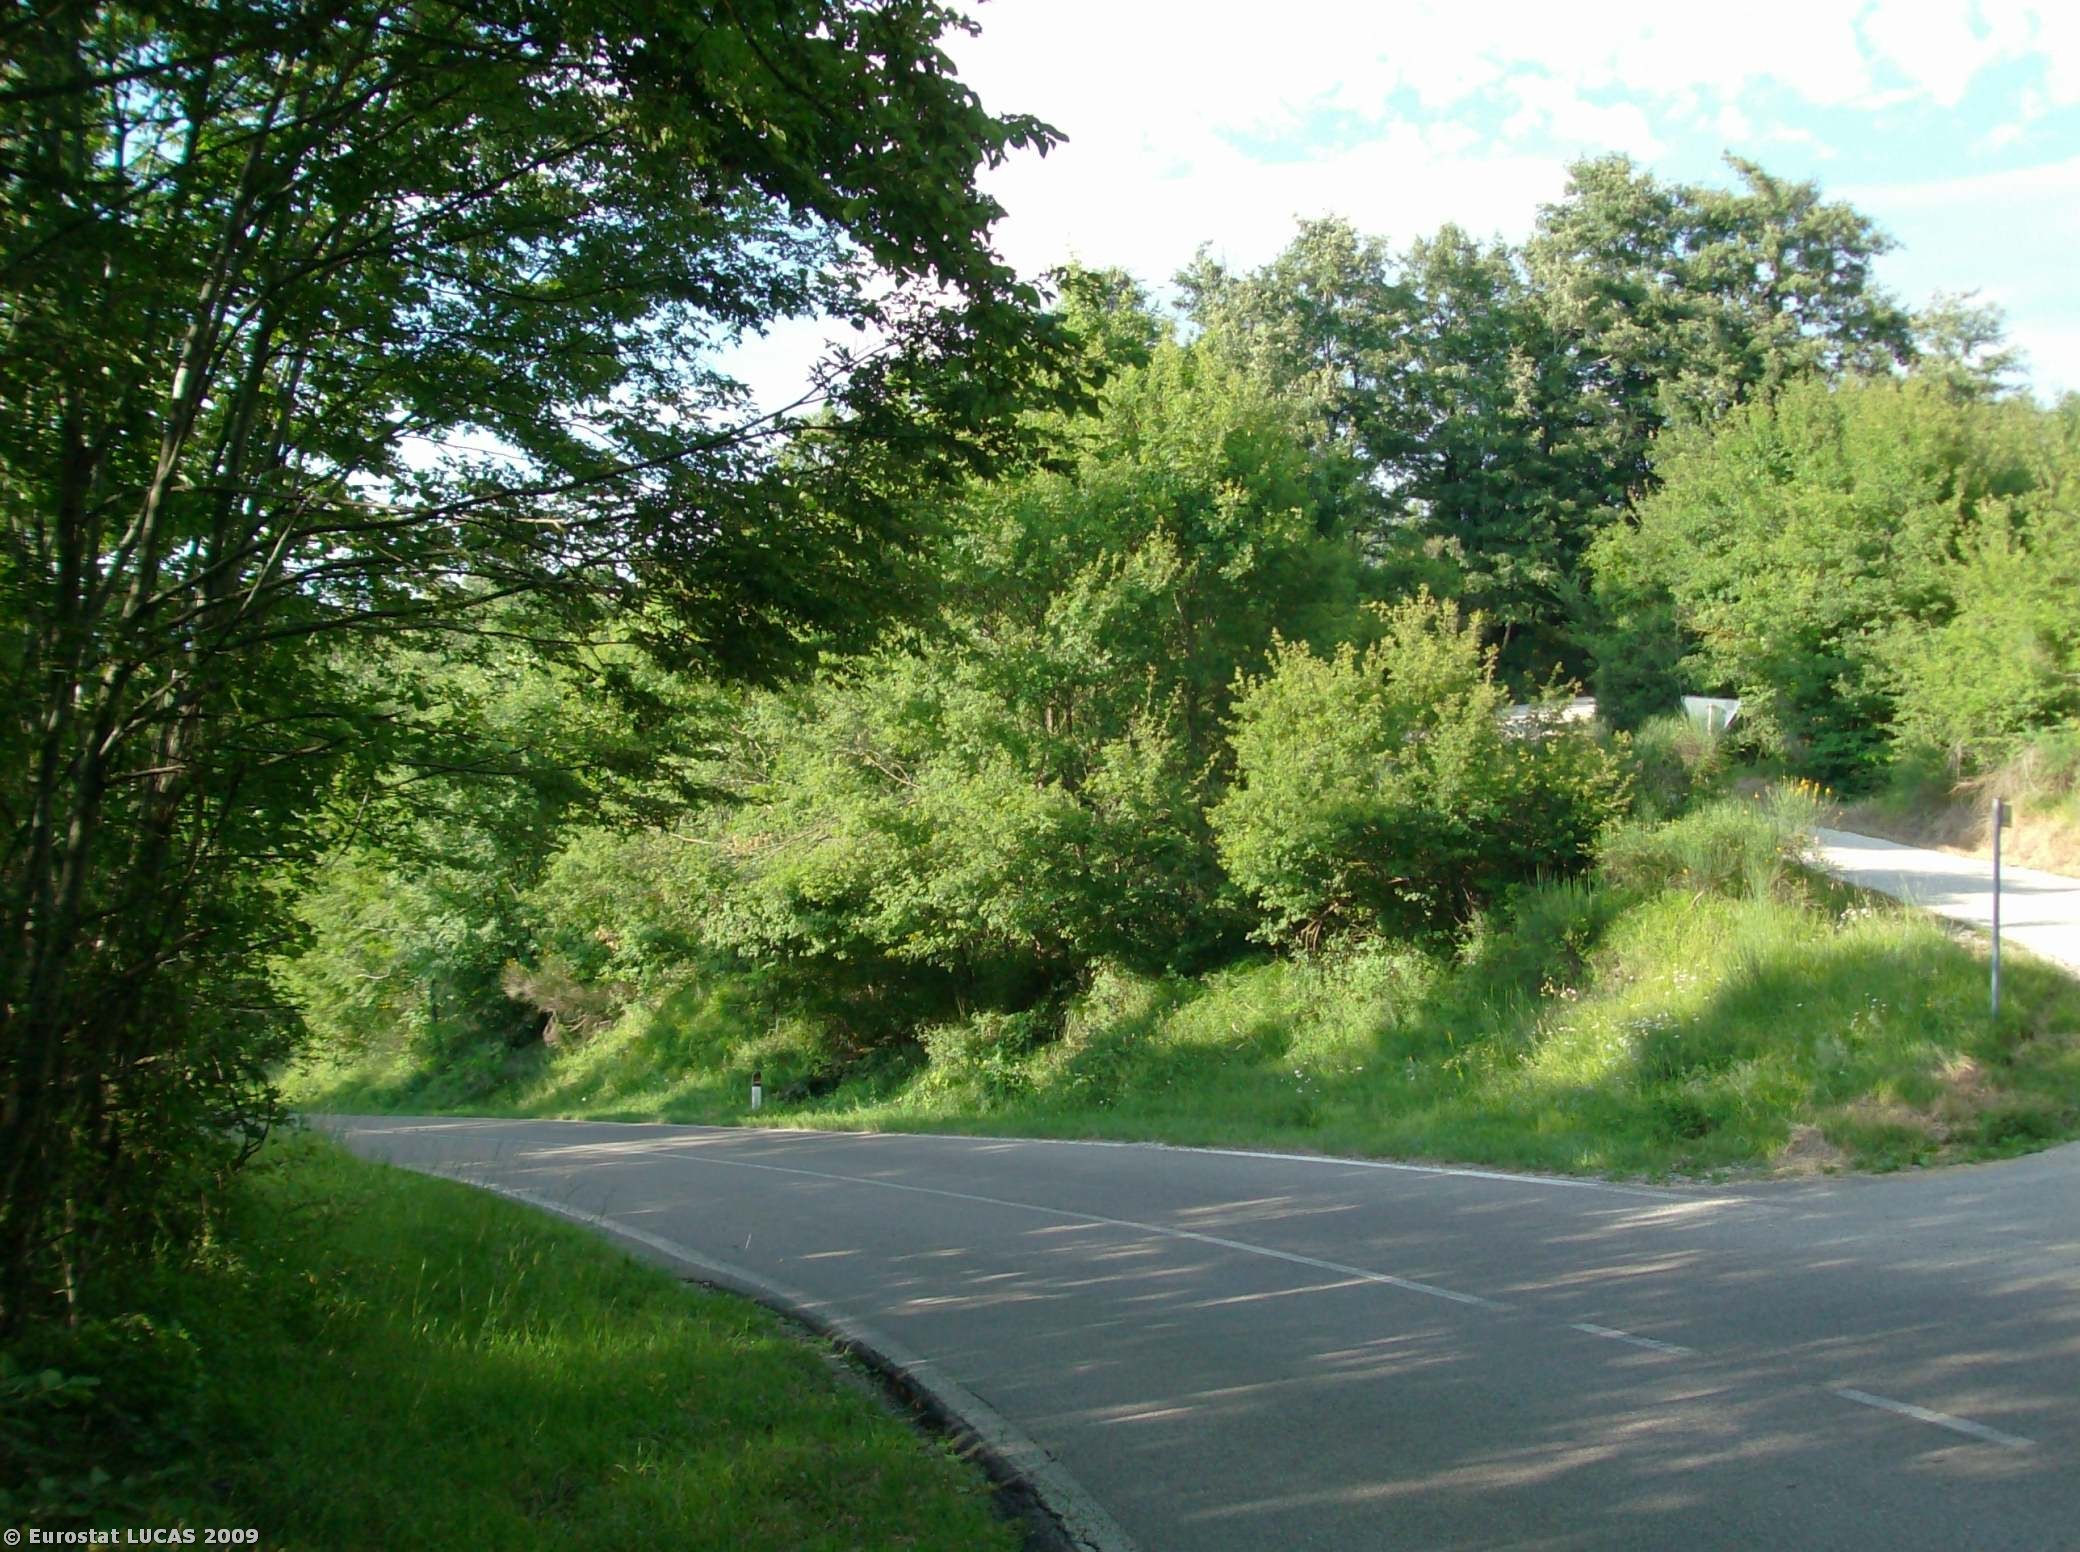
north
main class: Woodland
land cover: Broadleaved woodland
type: thermophilous deciduous forest
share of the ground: > 75 %
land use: Forestry
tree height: > 5 m
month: June
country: IT
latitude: 42.8040
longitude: 11.5967
